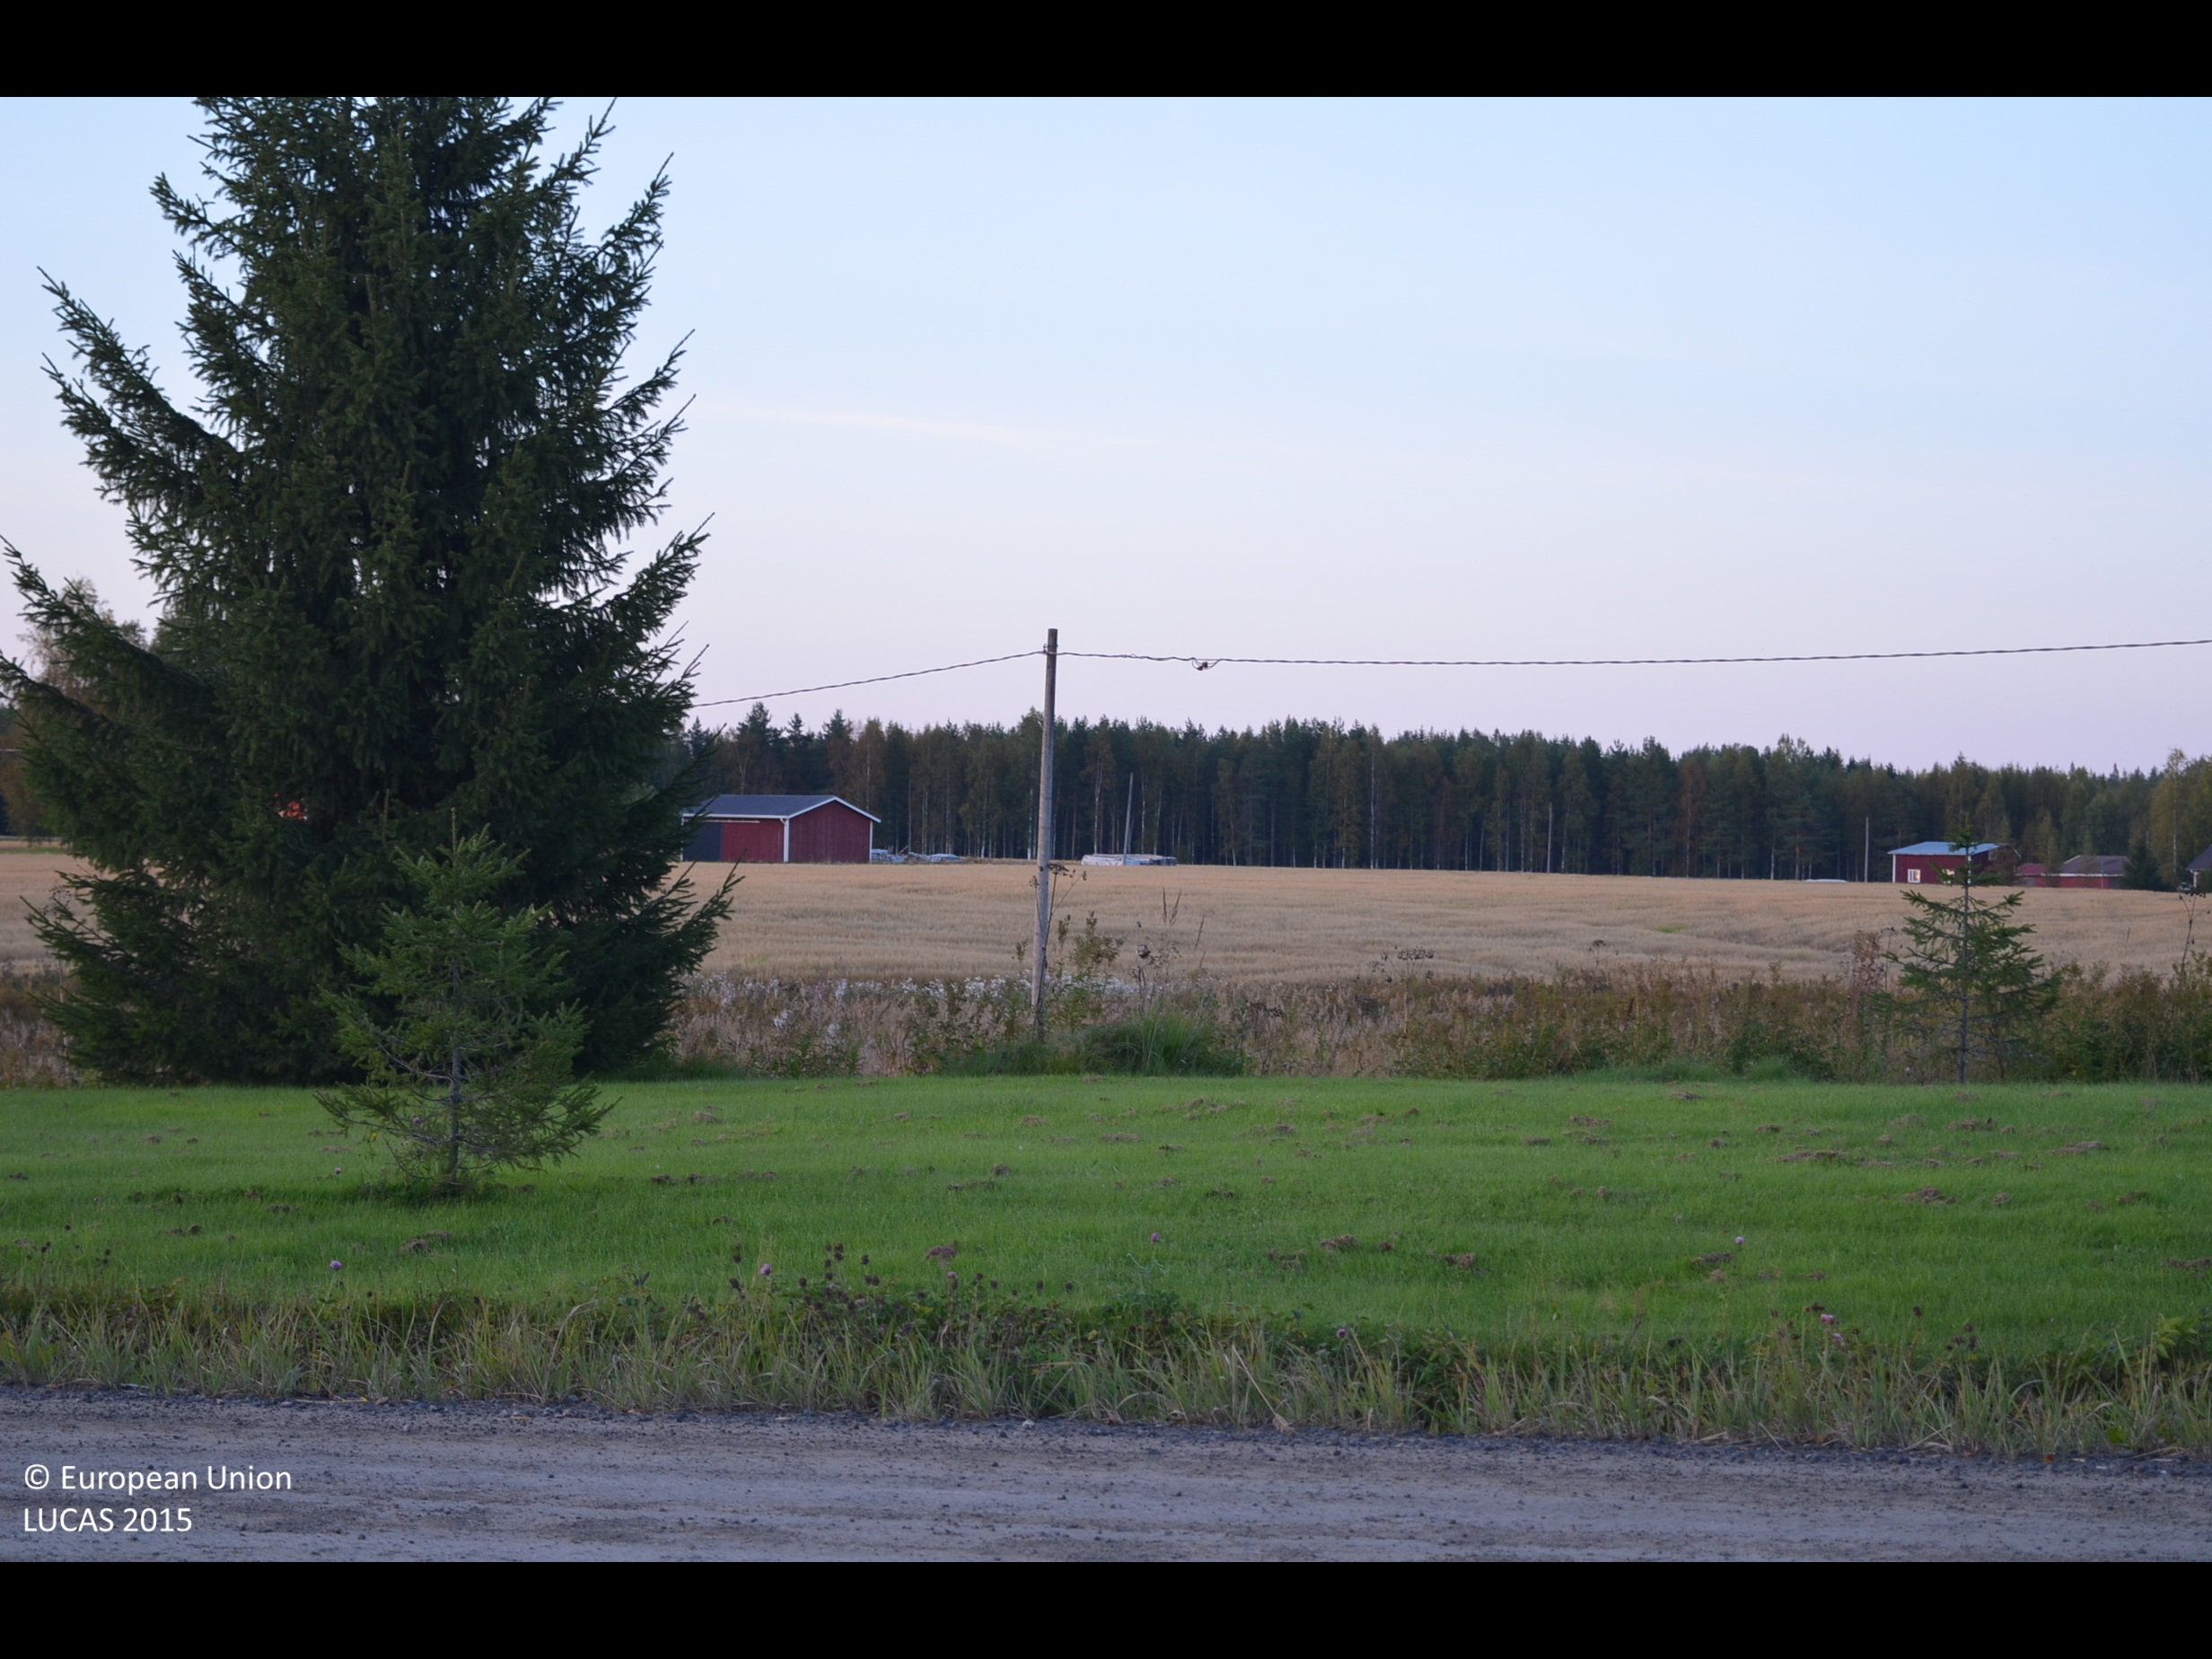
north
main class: Cropland
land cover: Oats
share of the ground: > 75 %
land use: Agriculture (excluding fallow land and kitchen gardens)
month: September
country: FI
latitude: 62.9768
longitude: 24.0639
